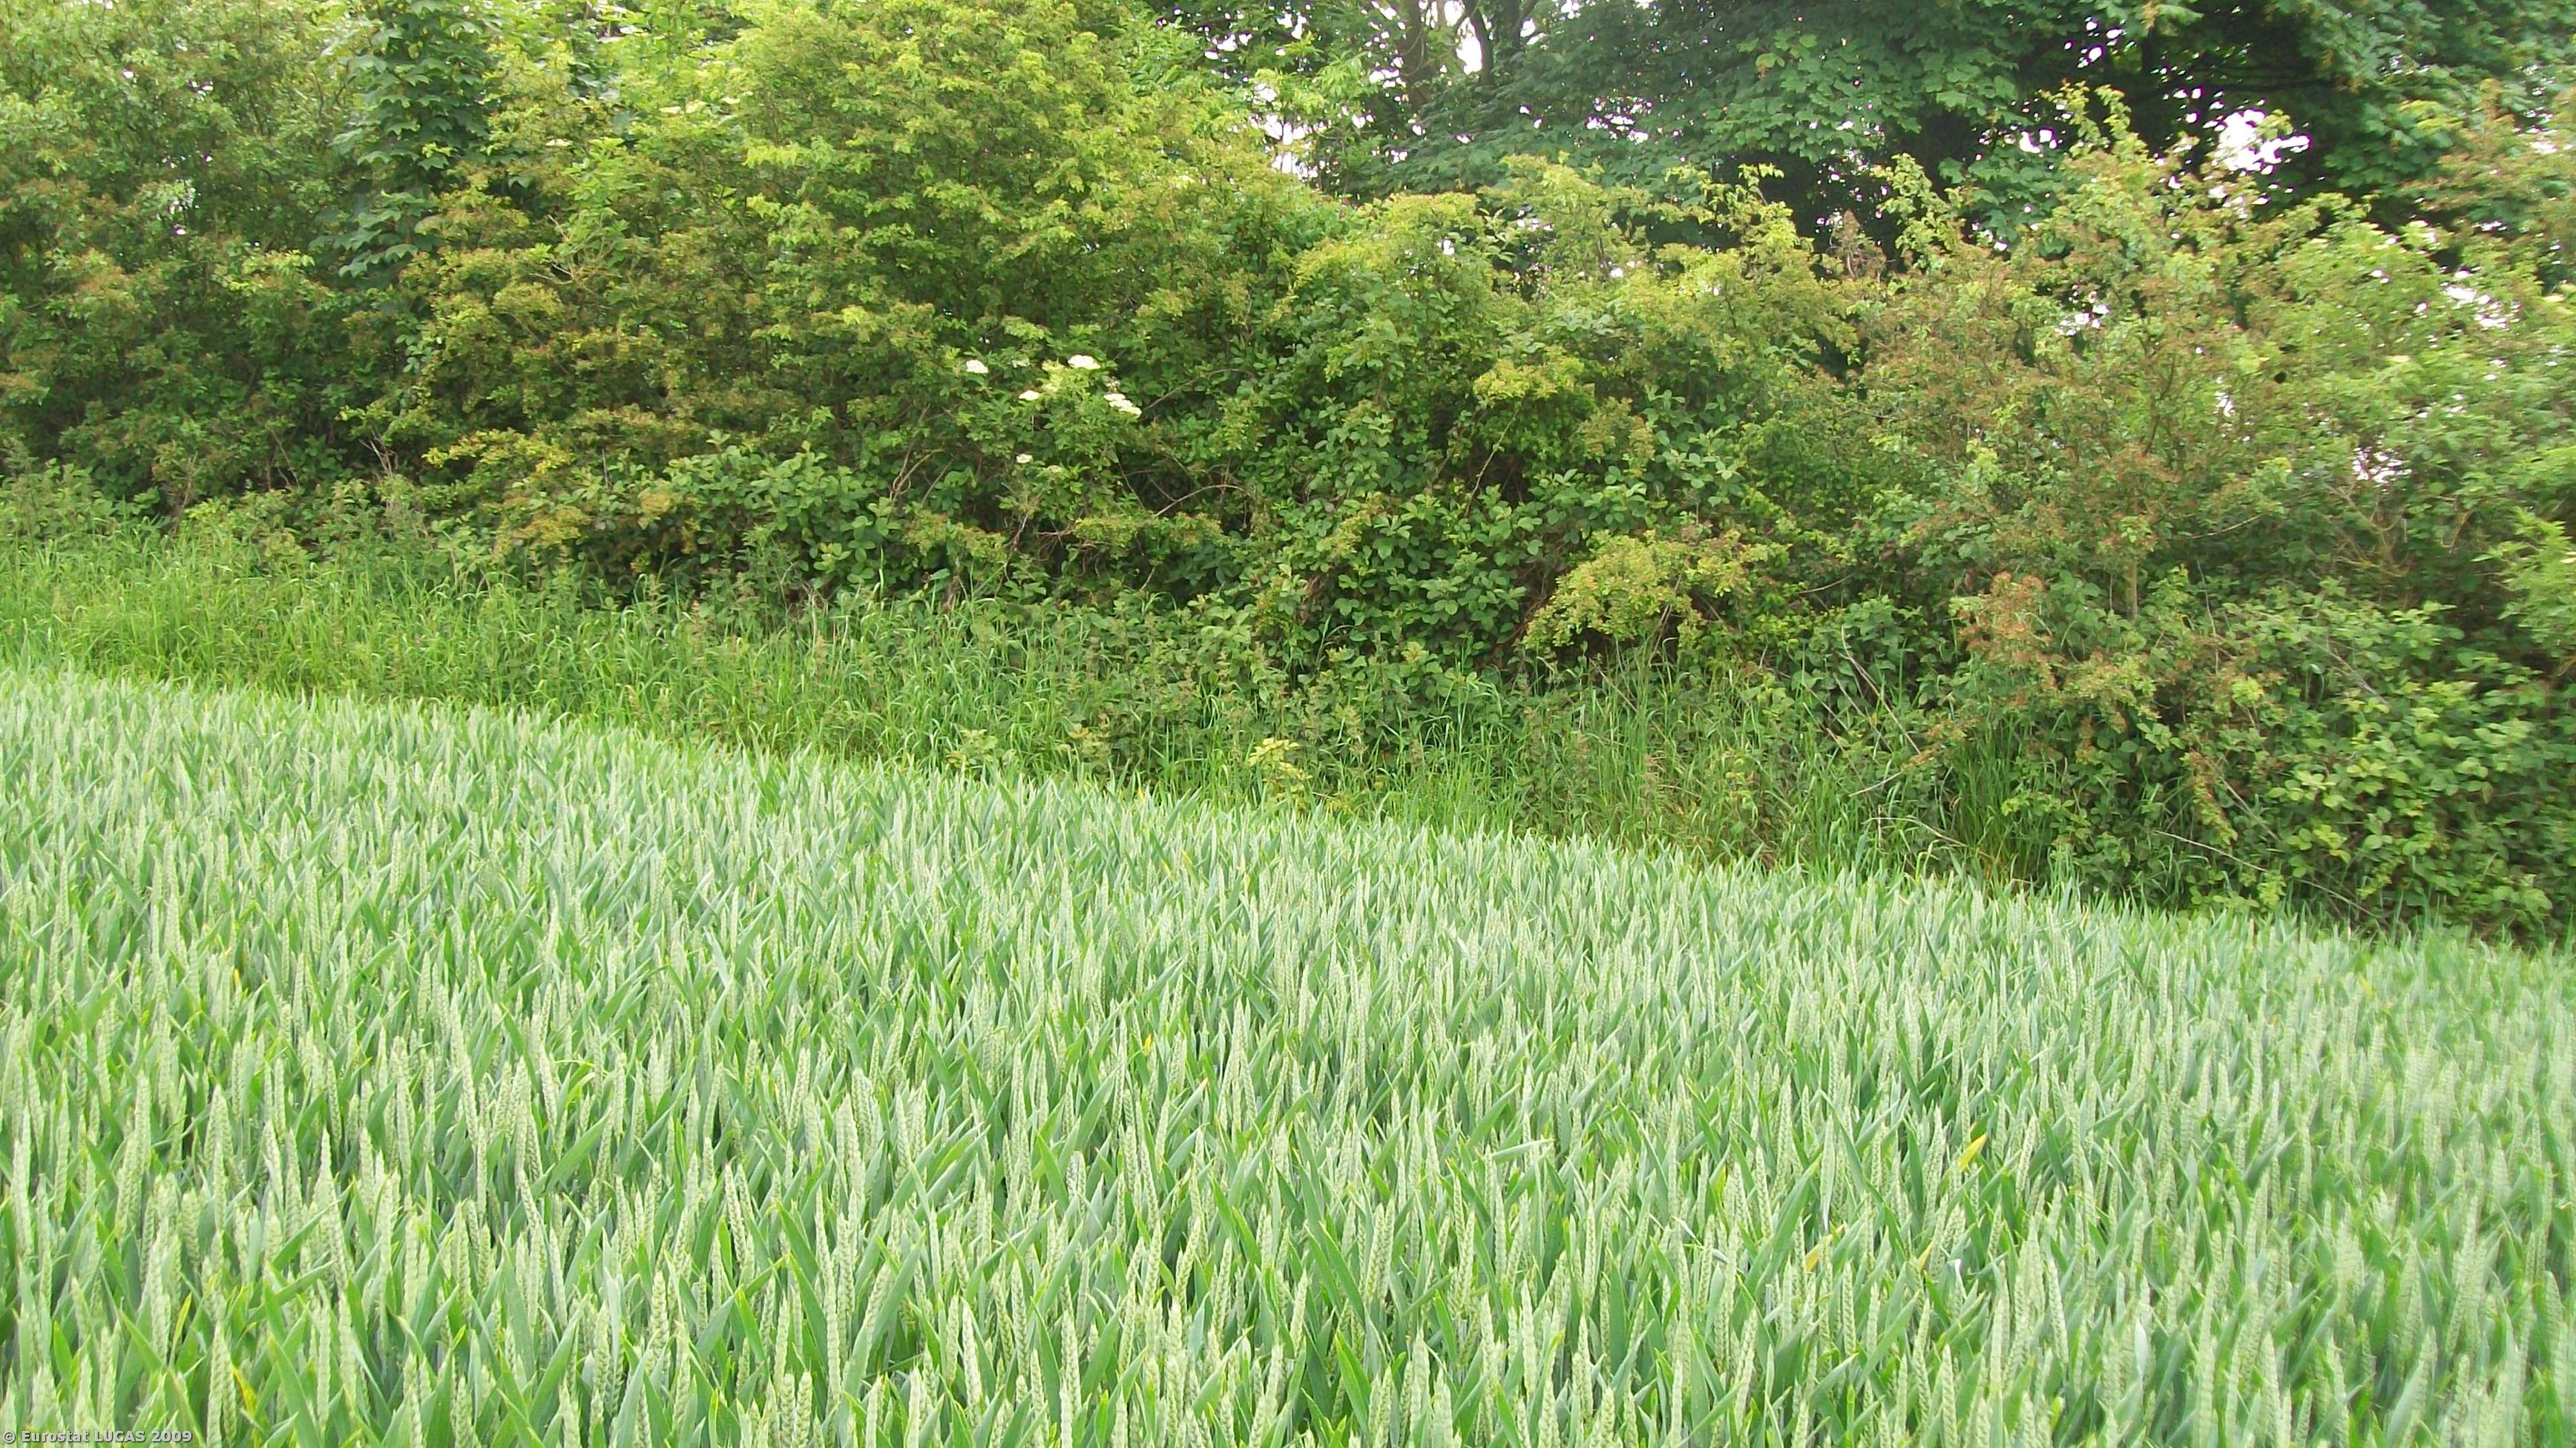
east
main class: Cropland
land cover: Common wheat
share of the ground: > 75 %
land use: Agriculture (excluding fallow land and kitchen gardens)
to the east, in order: Common wheat; Managed hedges; Common wheat
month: June
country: GB
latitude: 53.2189
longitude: -2.7247
